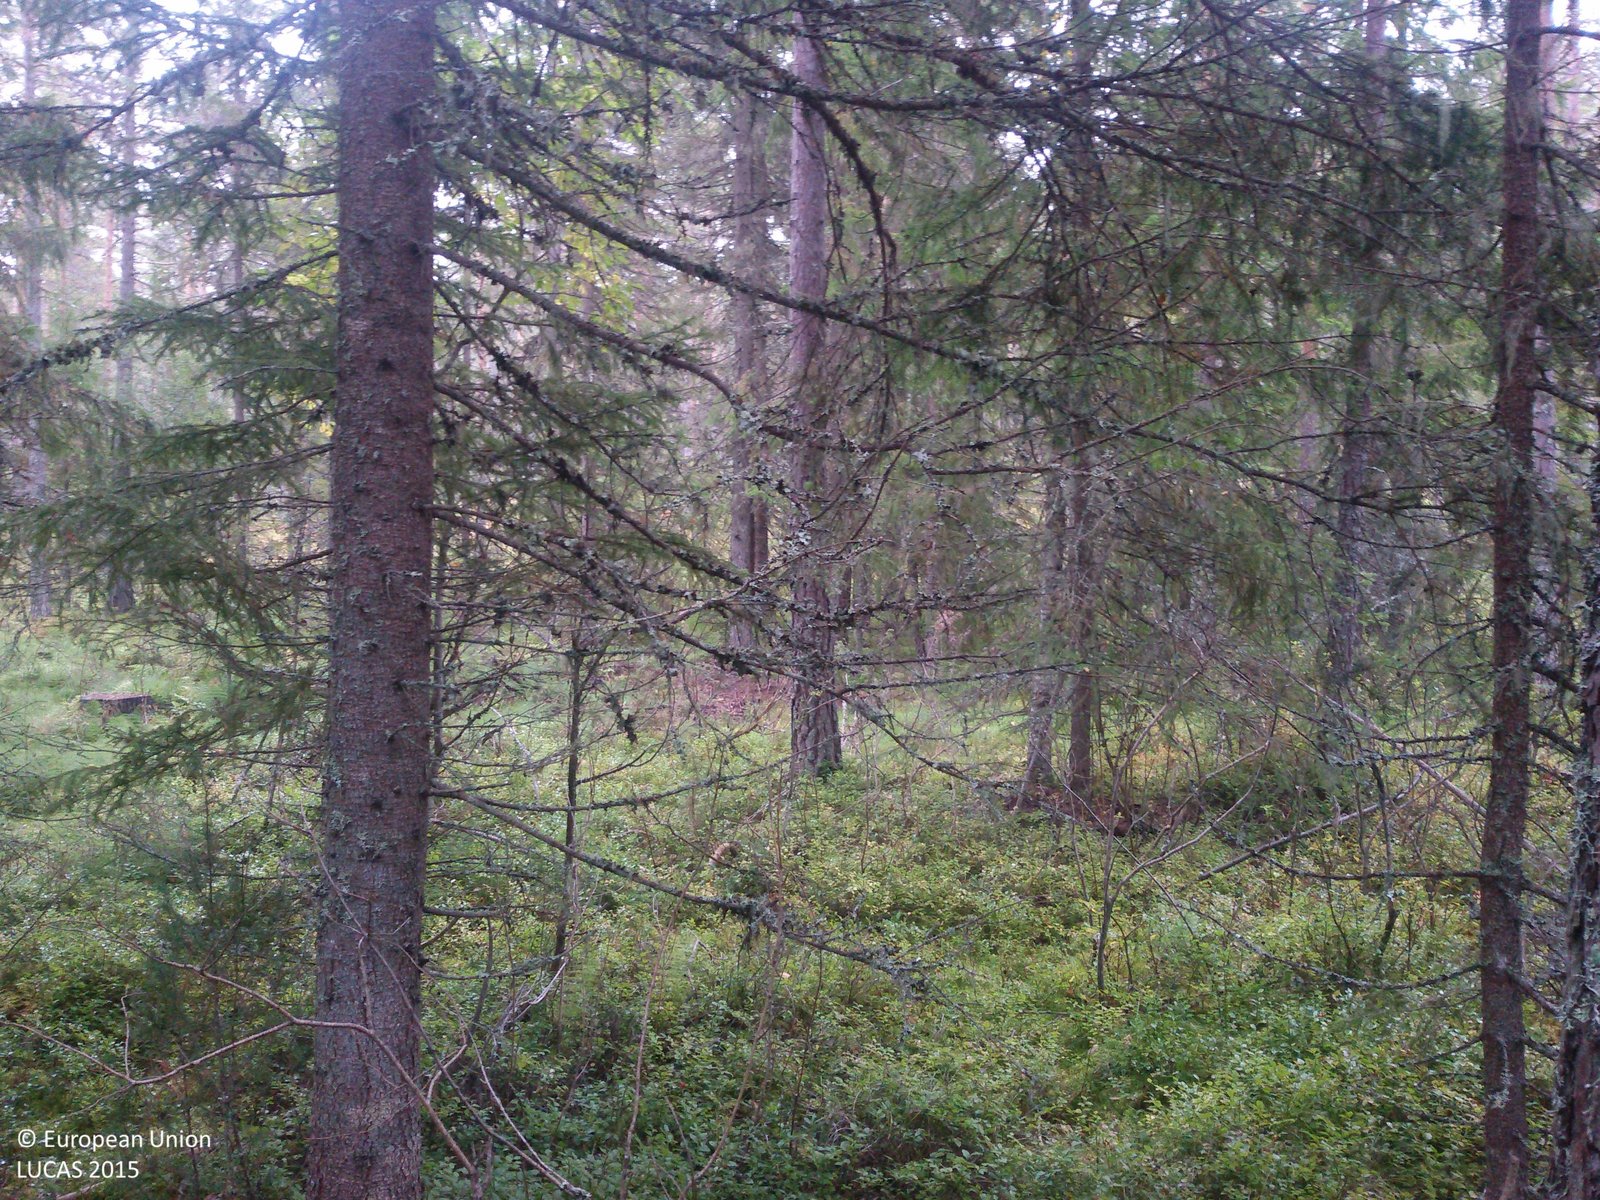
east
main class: Woodland
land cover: Other coniferous woodland
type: boreal forest
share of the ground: 50 - 75 %
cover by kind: coniferous forest trees 70 %, herbaceous plants 20 %, lichens and mosses 10 %
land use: Forestry
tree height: > 5 m
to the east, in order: Other coniferous woodland; Tracks; Pine dominated coniferous woodland; Tracks; Pine dominated coniferous woodland; Paved roads, cycling and walking lanes; Pine dominated coniferous woodland
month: September
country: SE
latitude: 61.0910
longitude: 14.2334
